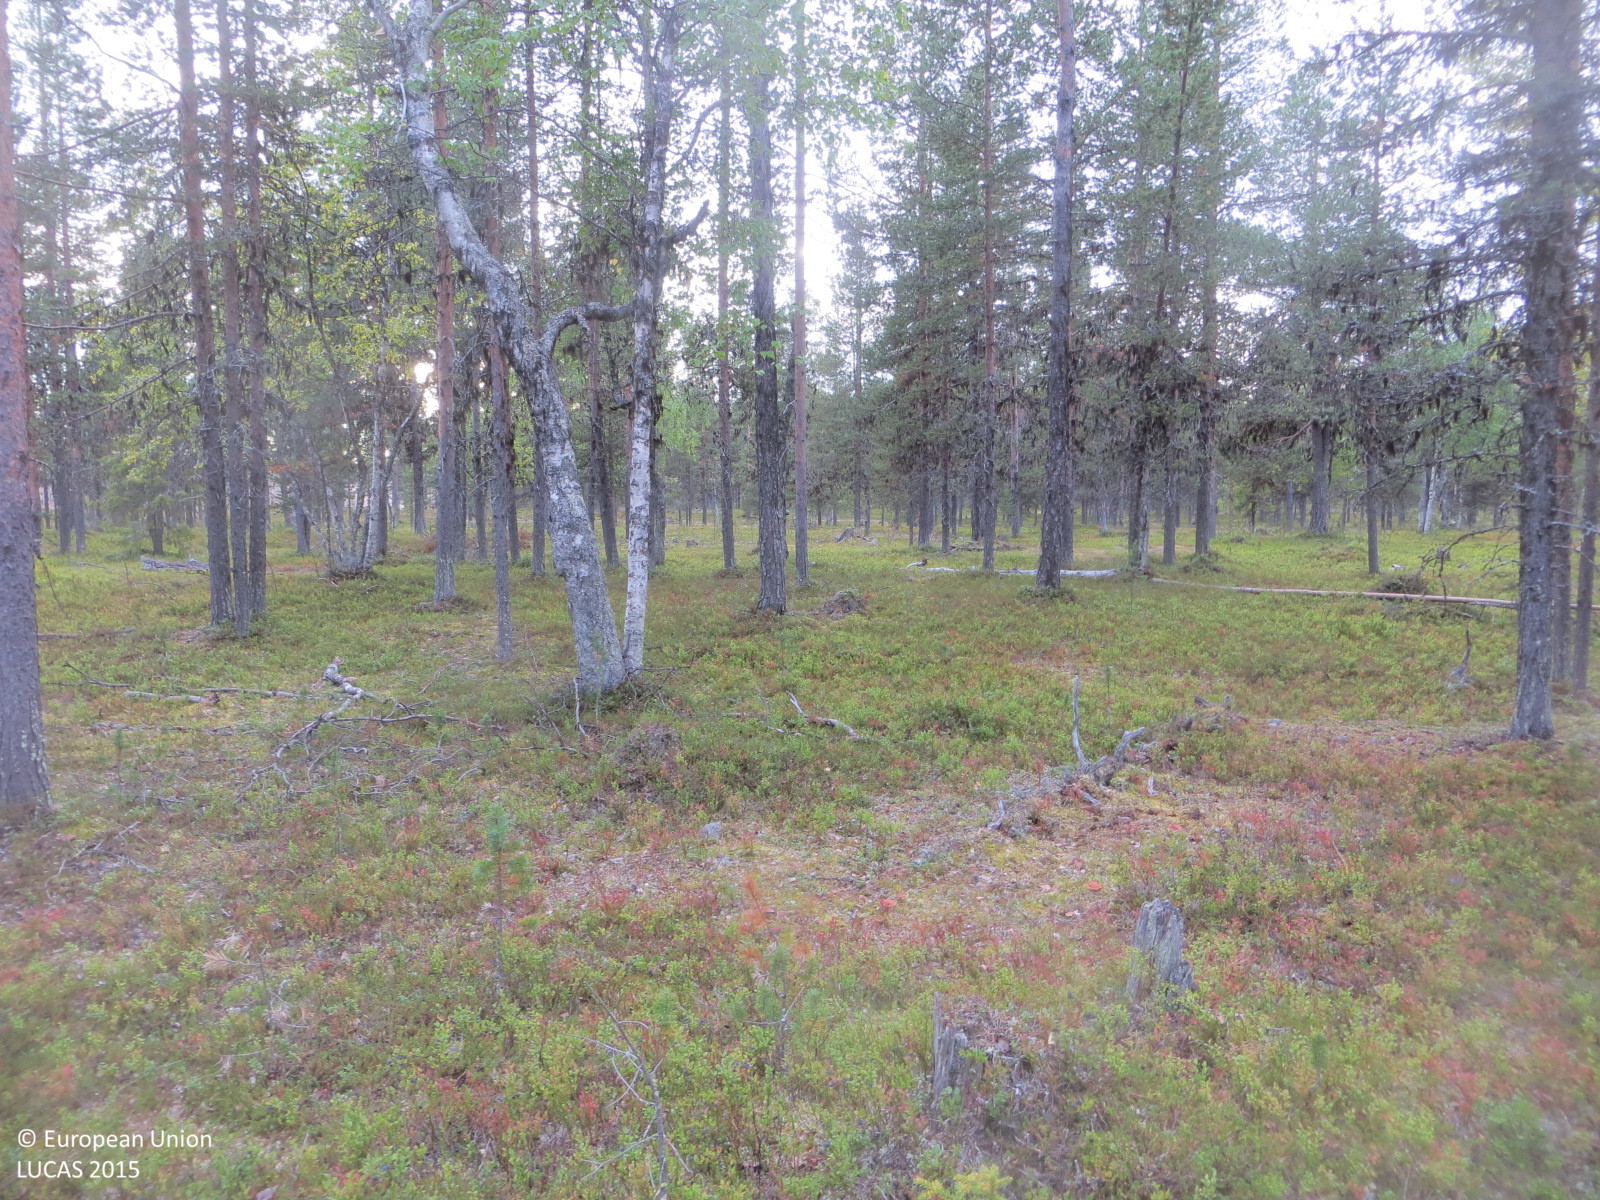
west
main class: Woodland
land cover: Pine dominated mixed woodland
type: boreal forest
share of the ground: 25 - 50 %
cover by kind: shrubs 60 %, coniferous forest trees 30 %, broadleaved forest trees 10 %
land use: Forestry
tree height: > 5 m
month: September
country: FI
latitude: 67.9250
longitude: 24.4490
